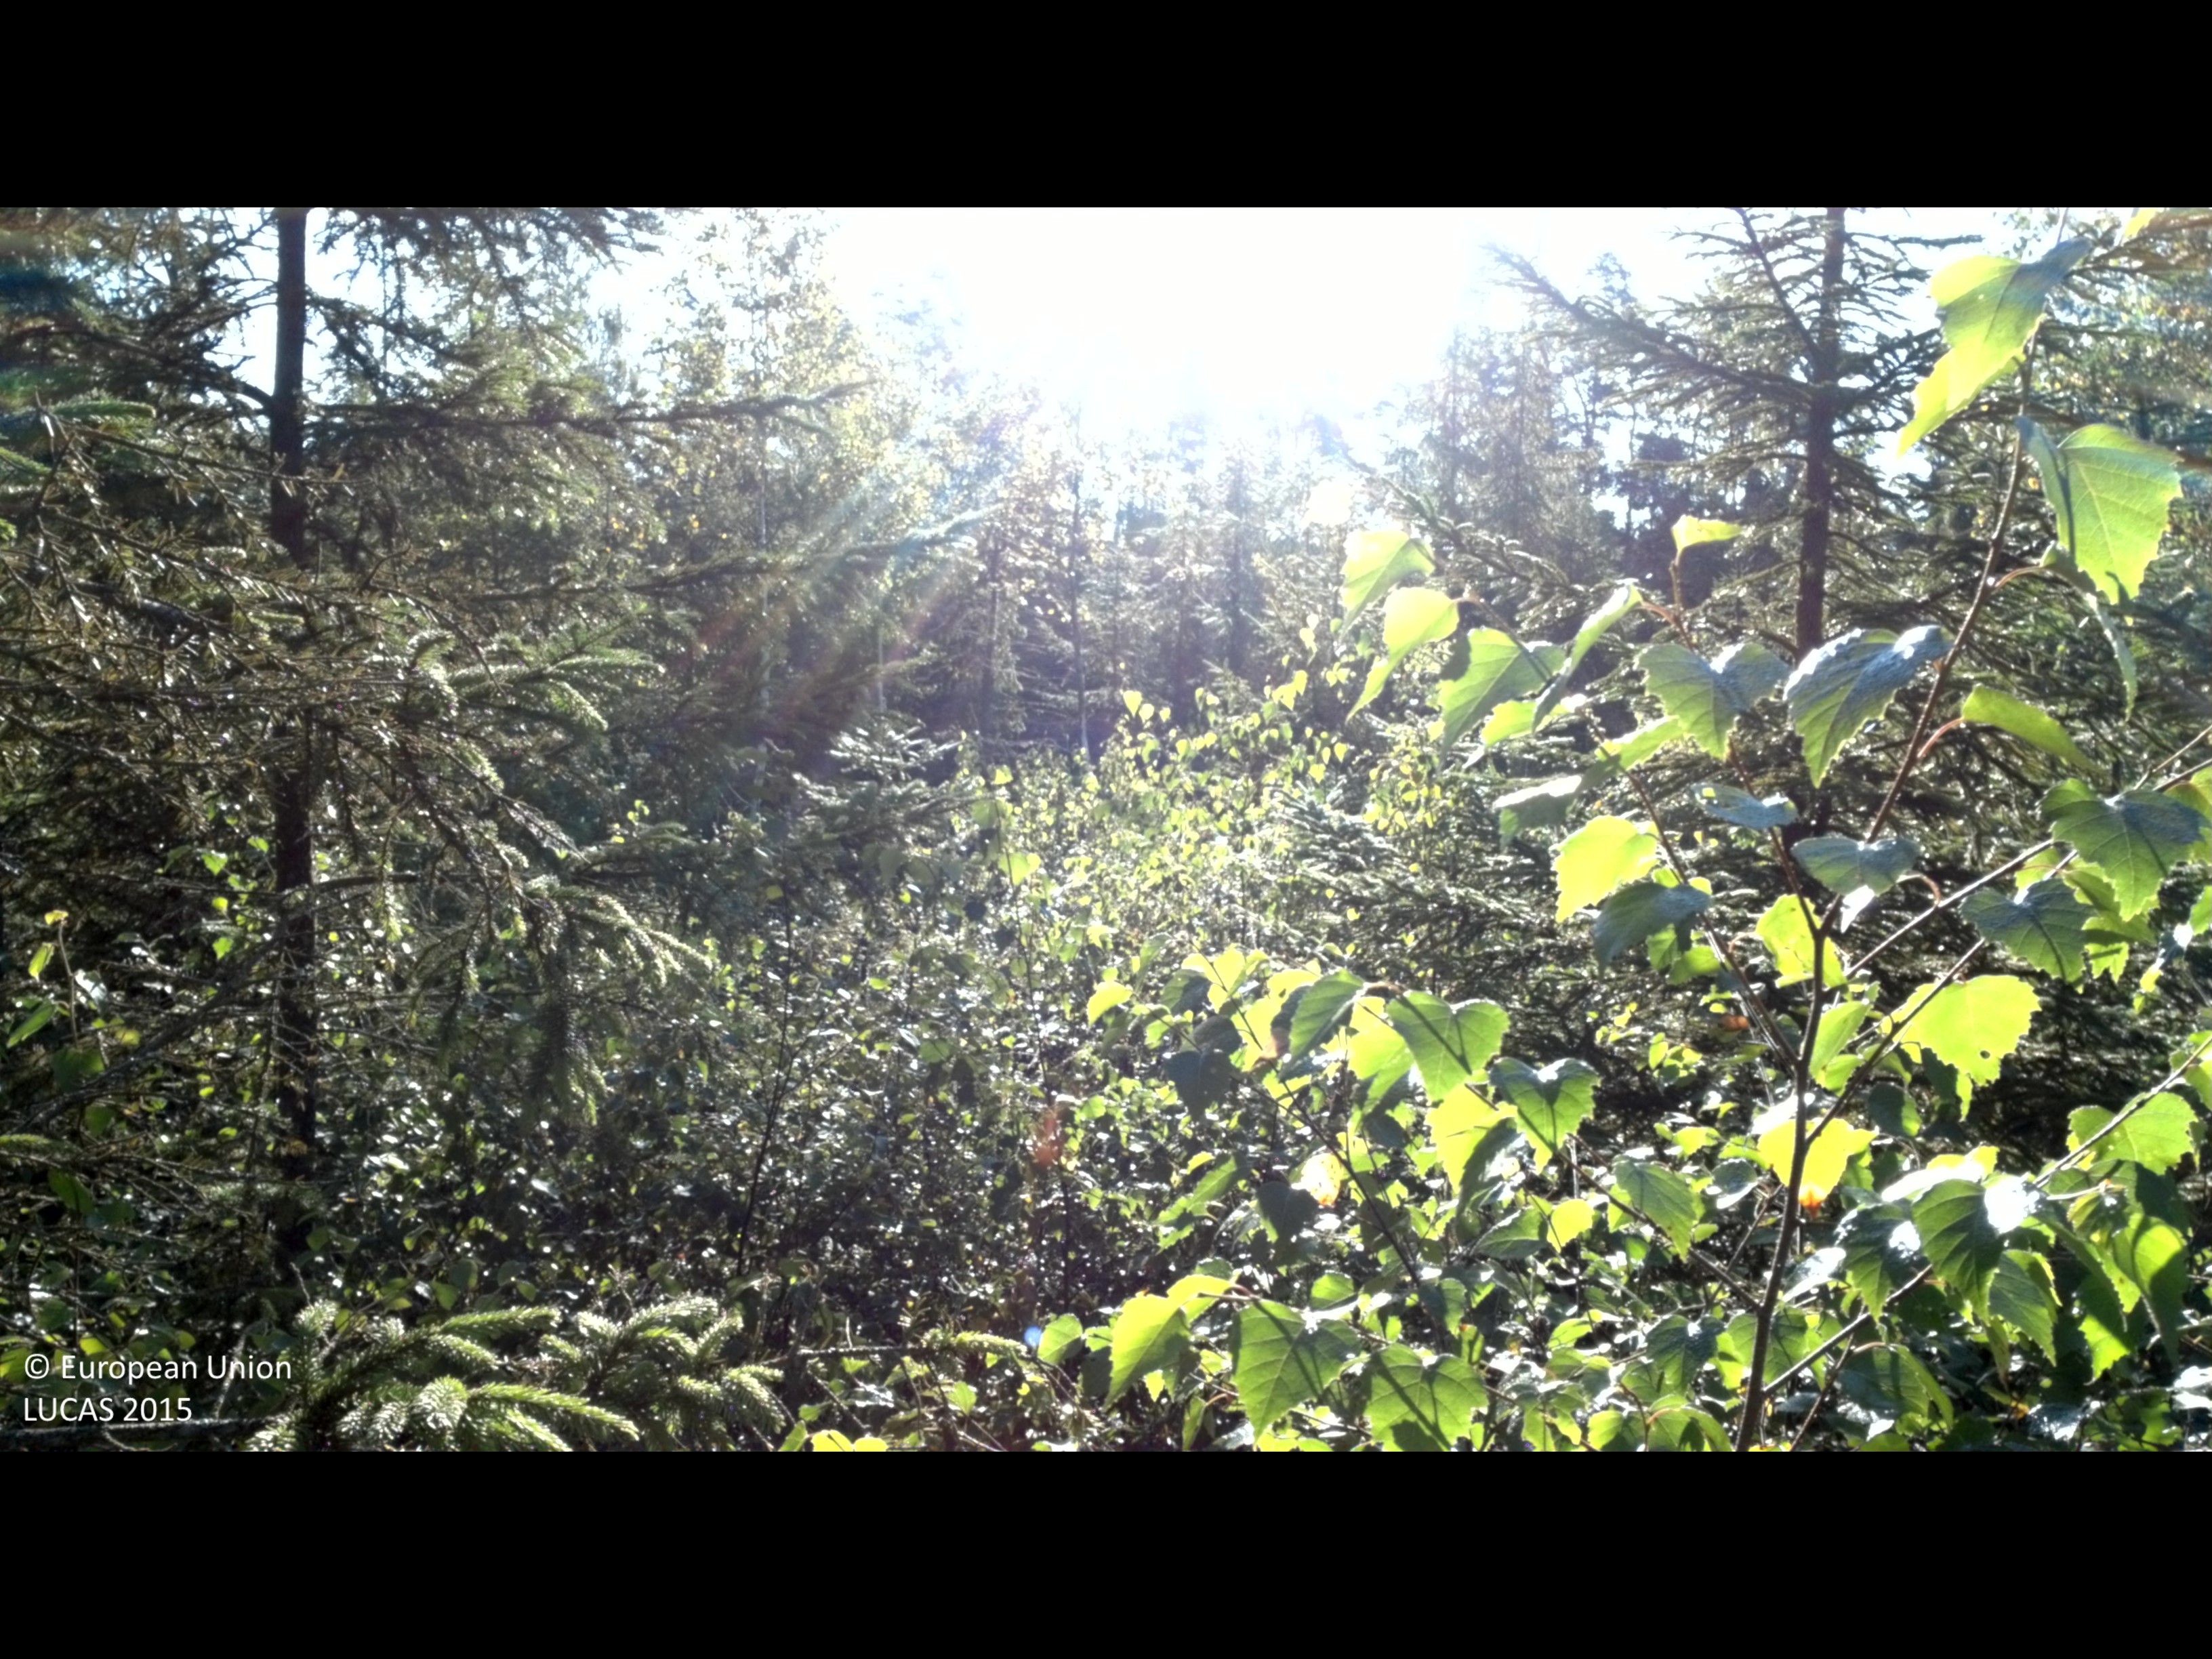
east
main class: Woodland
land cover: Spruce dominated mixed woodland
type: boreal forest
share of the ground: 50 - 75 %
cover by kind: coniferous forest trees 45 %, broadleaved forest trees 30 %, shrubs 25 %
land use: Forestry
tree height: > 5 m
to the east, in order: Spruce dominated mixed woodland; Ditches and canals; Pine dominated mixed woodland; Spruce dominated mixed woodland; Spruce dominated coniferous woodland; Ditches and canals; Spruce dominated mixed woodland; Pine dominated mixed woodland; Spruce dominated coniferous woodland; Other coniferous woodland
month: August
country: SE
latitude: 56.9567
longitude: 13.2358
